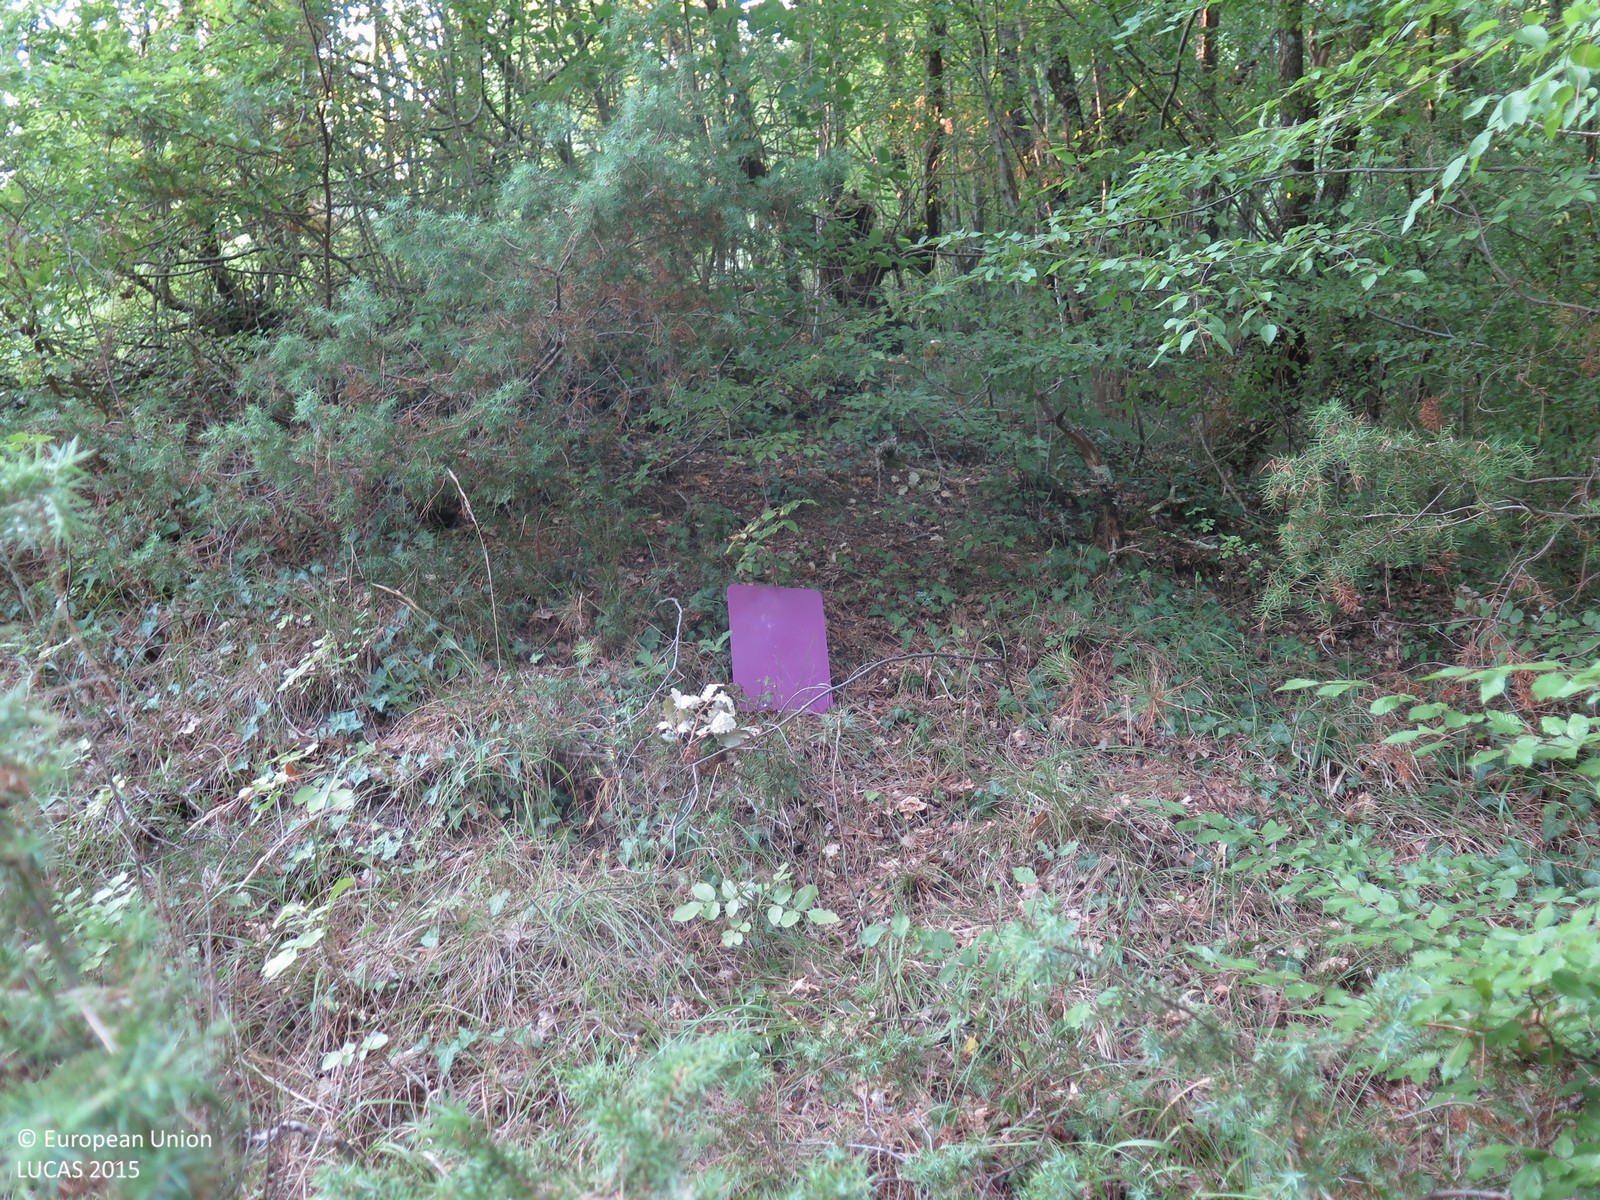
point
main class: Woodland
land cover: Broadleaved woodland
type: acidophilous oak and oak-birch forest
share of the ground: > 75 %
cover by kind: broadleaved forest trees 90 %, coniferous forest trees 5 %, herbaceous plants 5 %
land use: Semi-natural and natural areas not in use
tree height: > 5 m
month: July
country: HR
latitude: 45.2620
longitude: 14.1111
